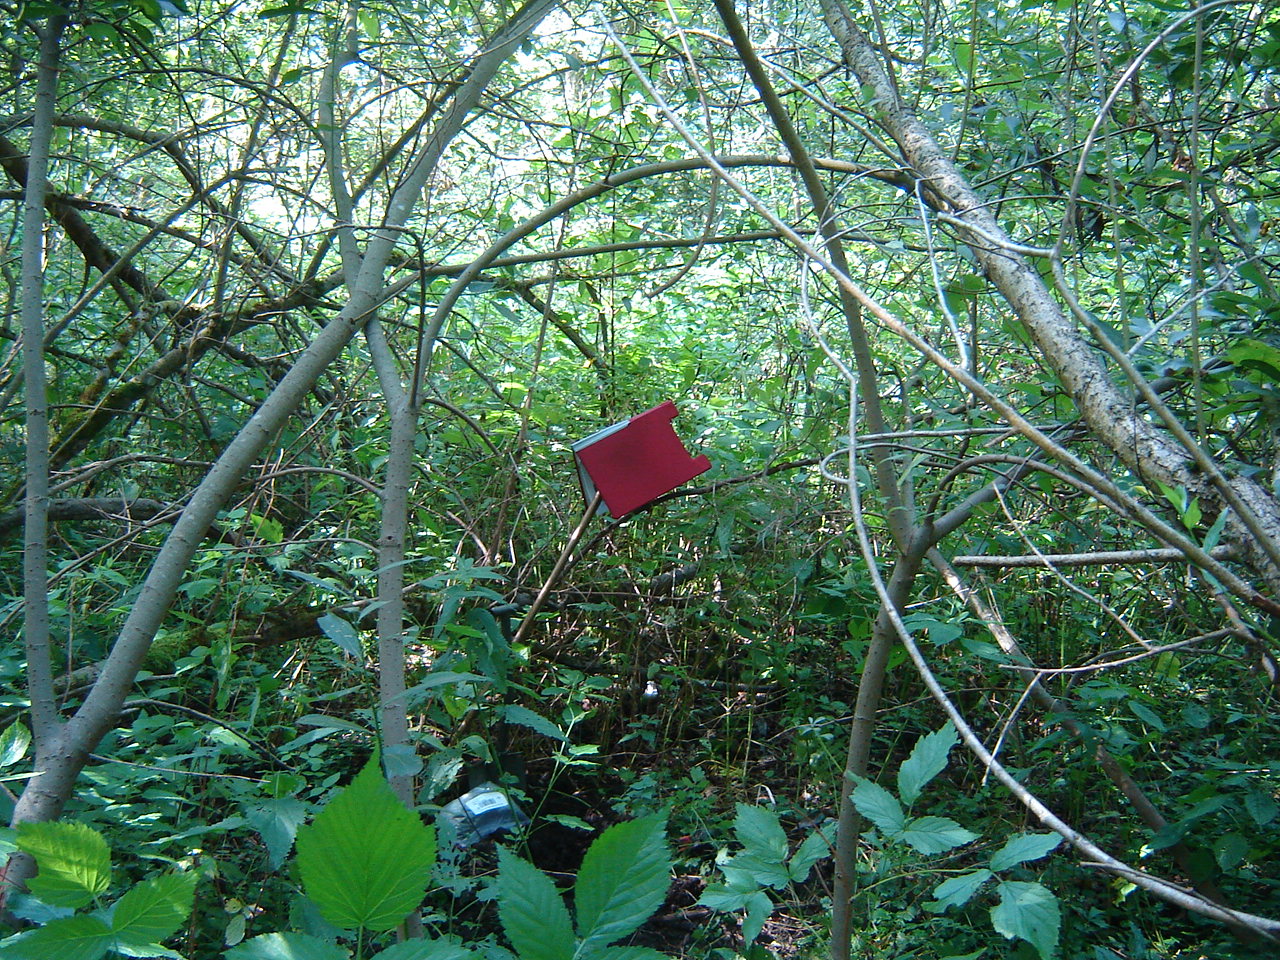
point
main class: Woodland
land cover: Broadleaved woodland
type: non-riverine alder, birch or aspen forest
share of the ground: > 75 %
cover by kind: broadleaved forest trees 85 %, herbaceous plants 15 %
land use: Forestry
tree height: > 5 m
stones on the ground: < 10 %
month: August
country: LT
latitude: 54.8400
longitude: 25.3032
